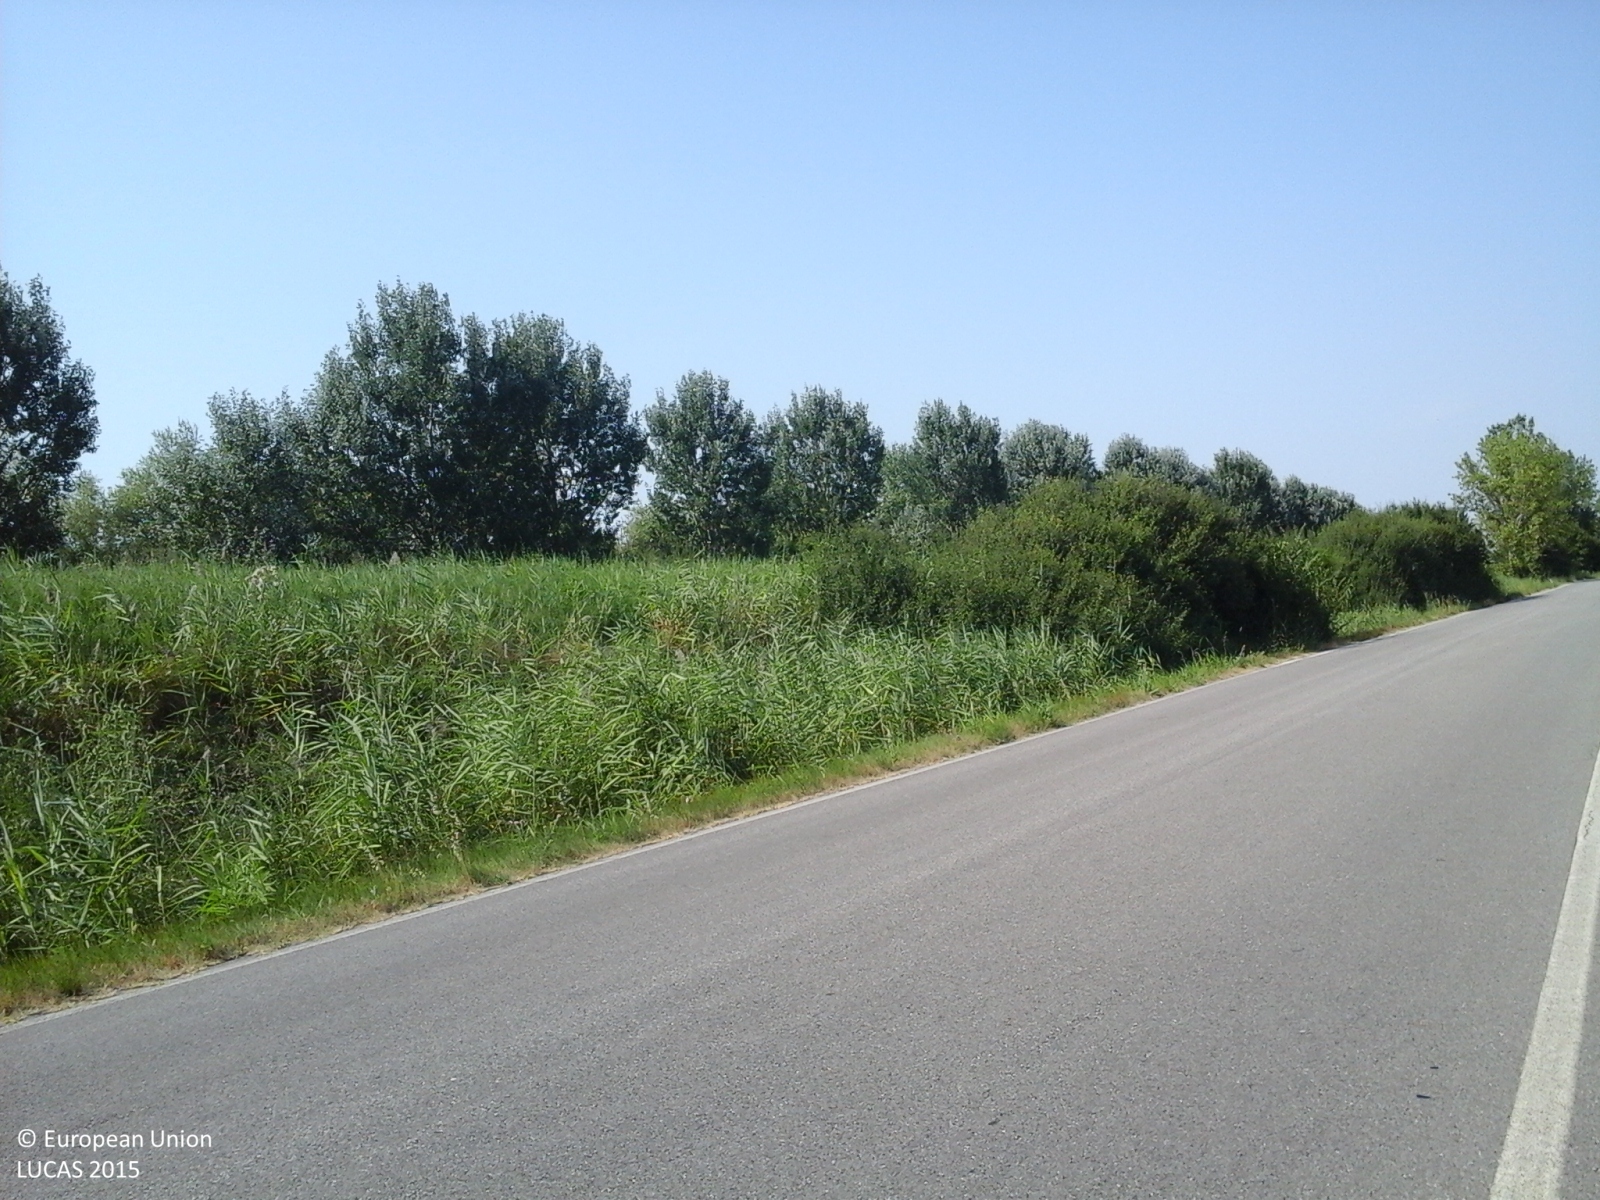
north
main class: Cropland
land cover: Lucerne
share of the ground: > 75 %
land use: Agriculture (excluding fallow land and kitchen gardens)
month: July
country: IT
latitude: 44.5351
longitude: 11.6953
